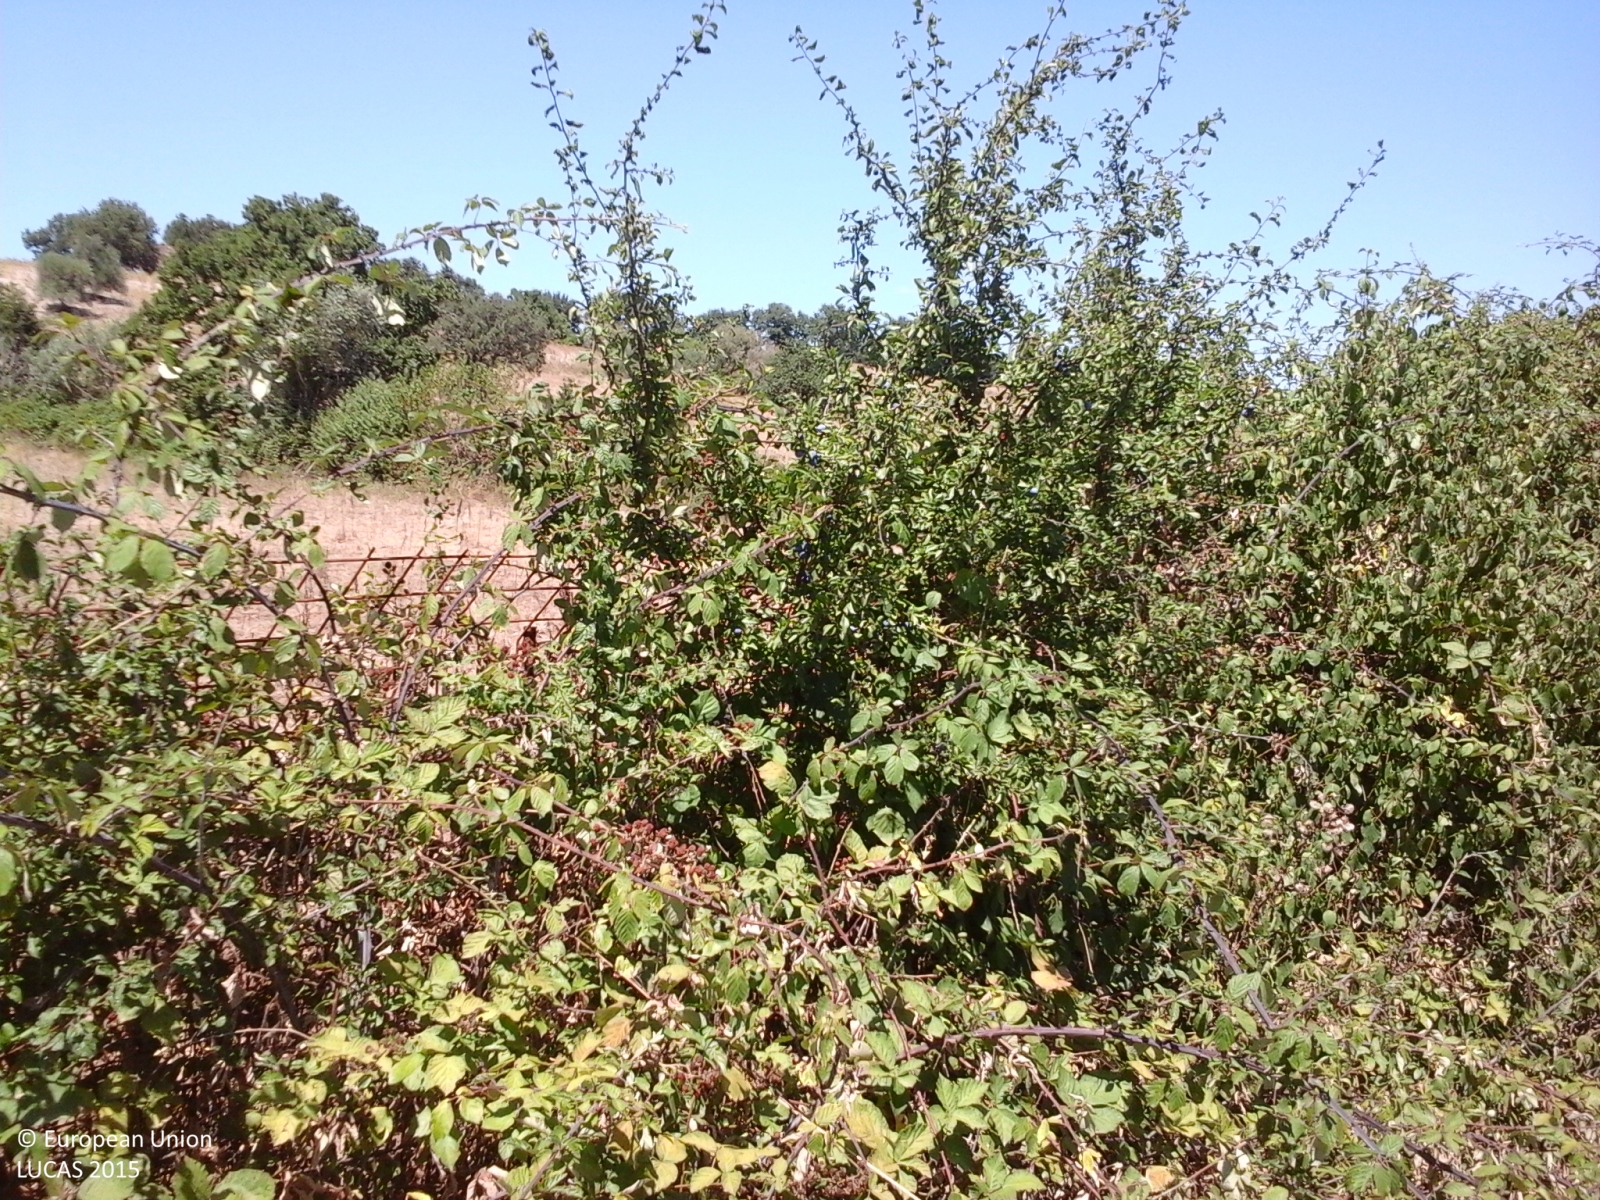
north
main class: Cropland
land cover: Temporary grasslands
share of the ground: > 75 %
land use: Agriculture (excluding fallow land and kitchen gardens)
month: August
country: IT
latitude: 42.6415
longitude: 11.5924
